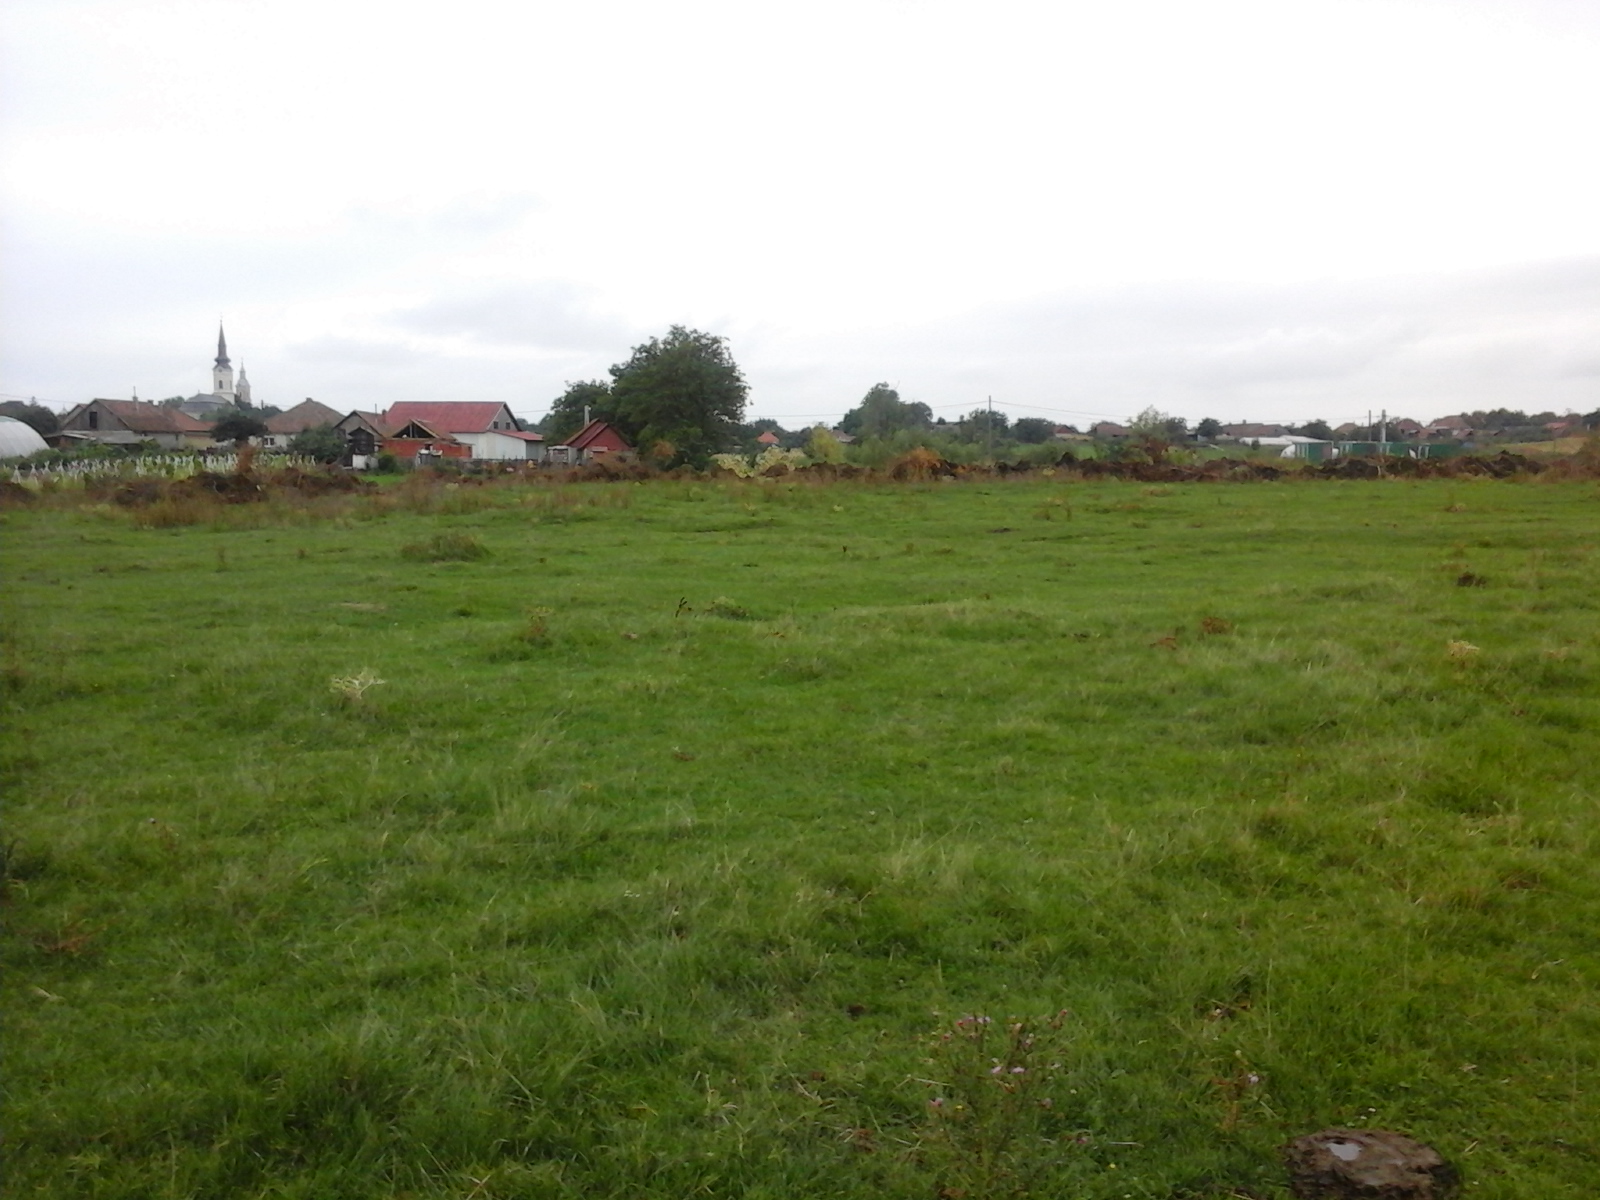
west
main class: Grassland
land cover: Spontaneously vegetated surfaces
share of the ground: > 75 %
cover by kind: herbaceous plants 100 %
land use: Agriculture (excluding fallow land and kitchen gardens)
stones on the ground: < 10 %
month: September
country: RO
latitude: 47.1547
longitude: 21.9303
